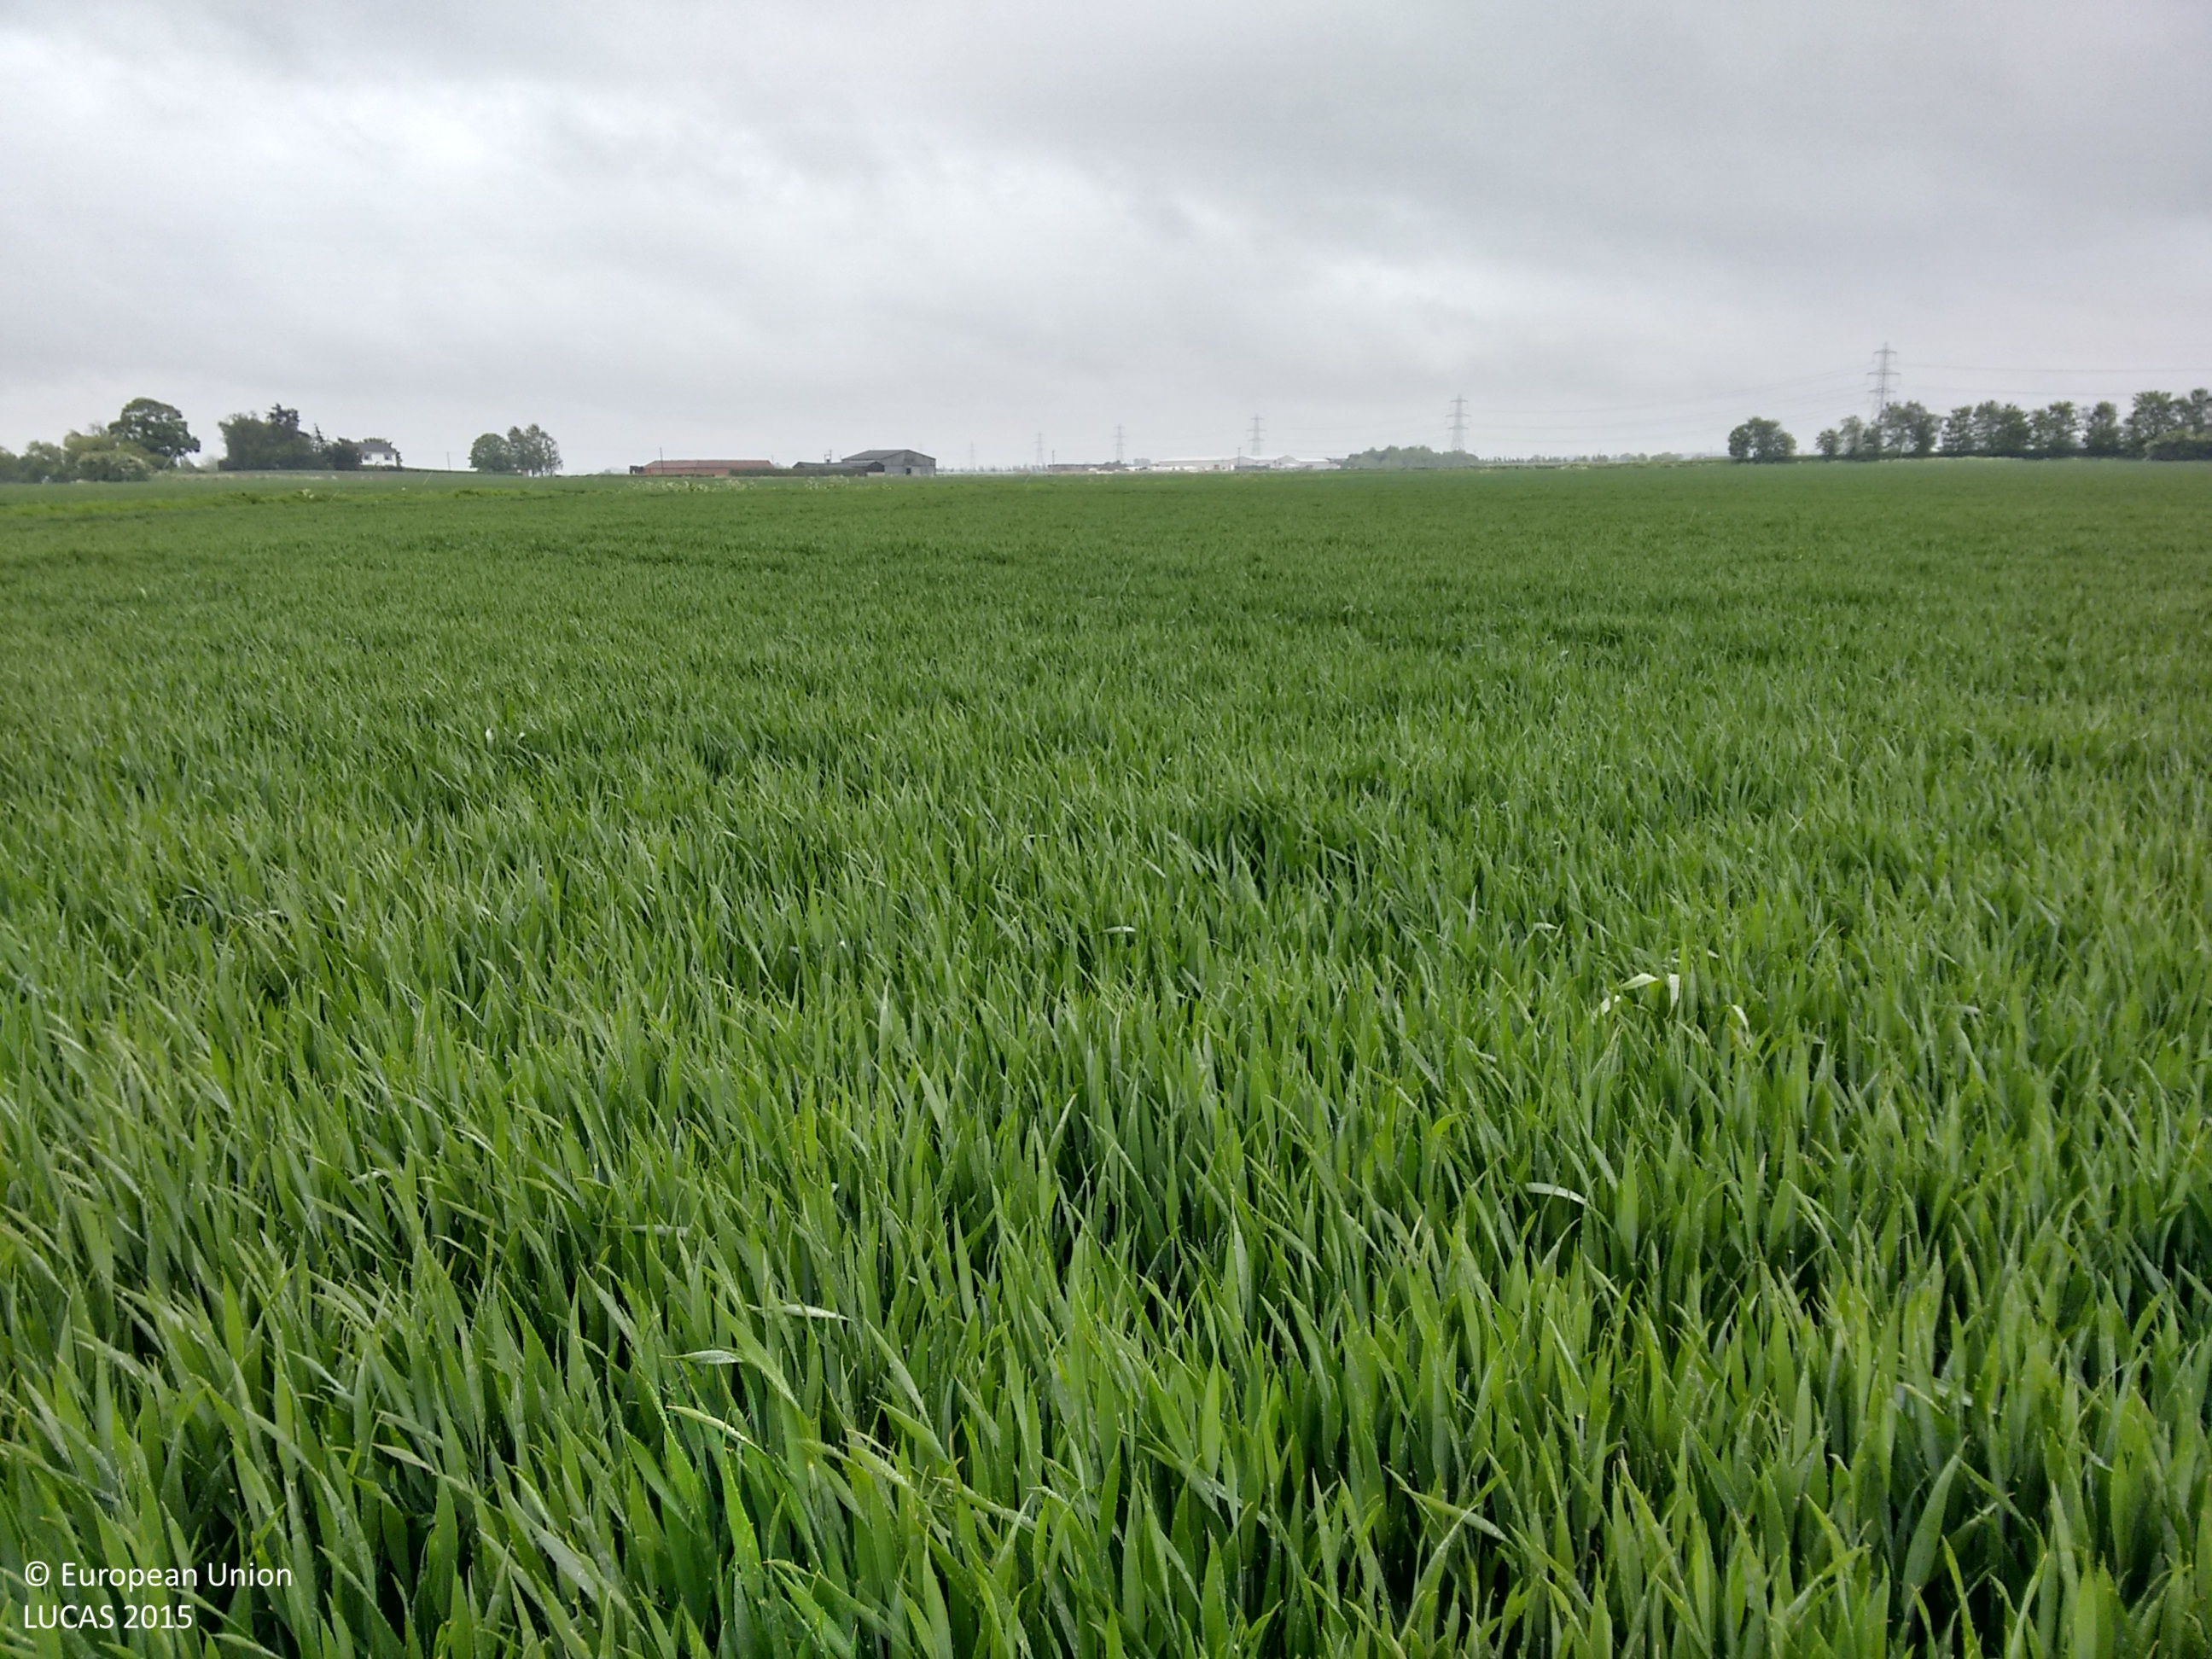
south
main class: Cropland
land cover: Common wheat
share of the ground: > 75 %
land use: Agriculture (excluding fallow land and kitchen gardens)
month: May
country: GB
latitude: 52.8859
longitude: -0.1245
